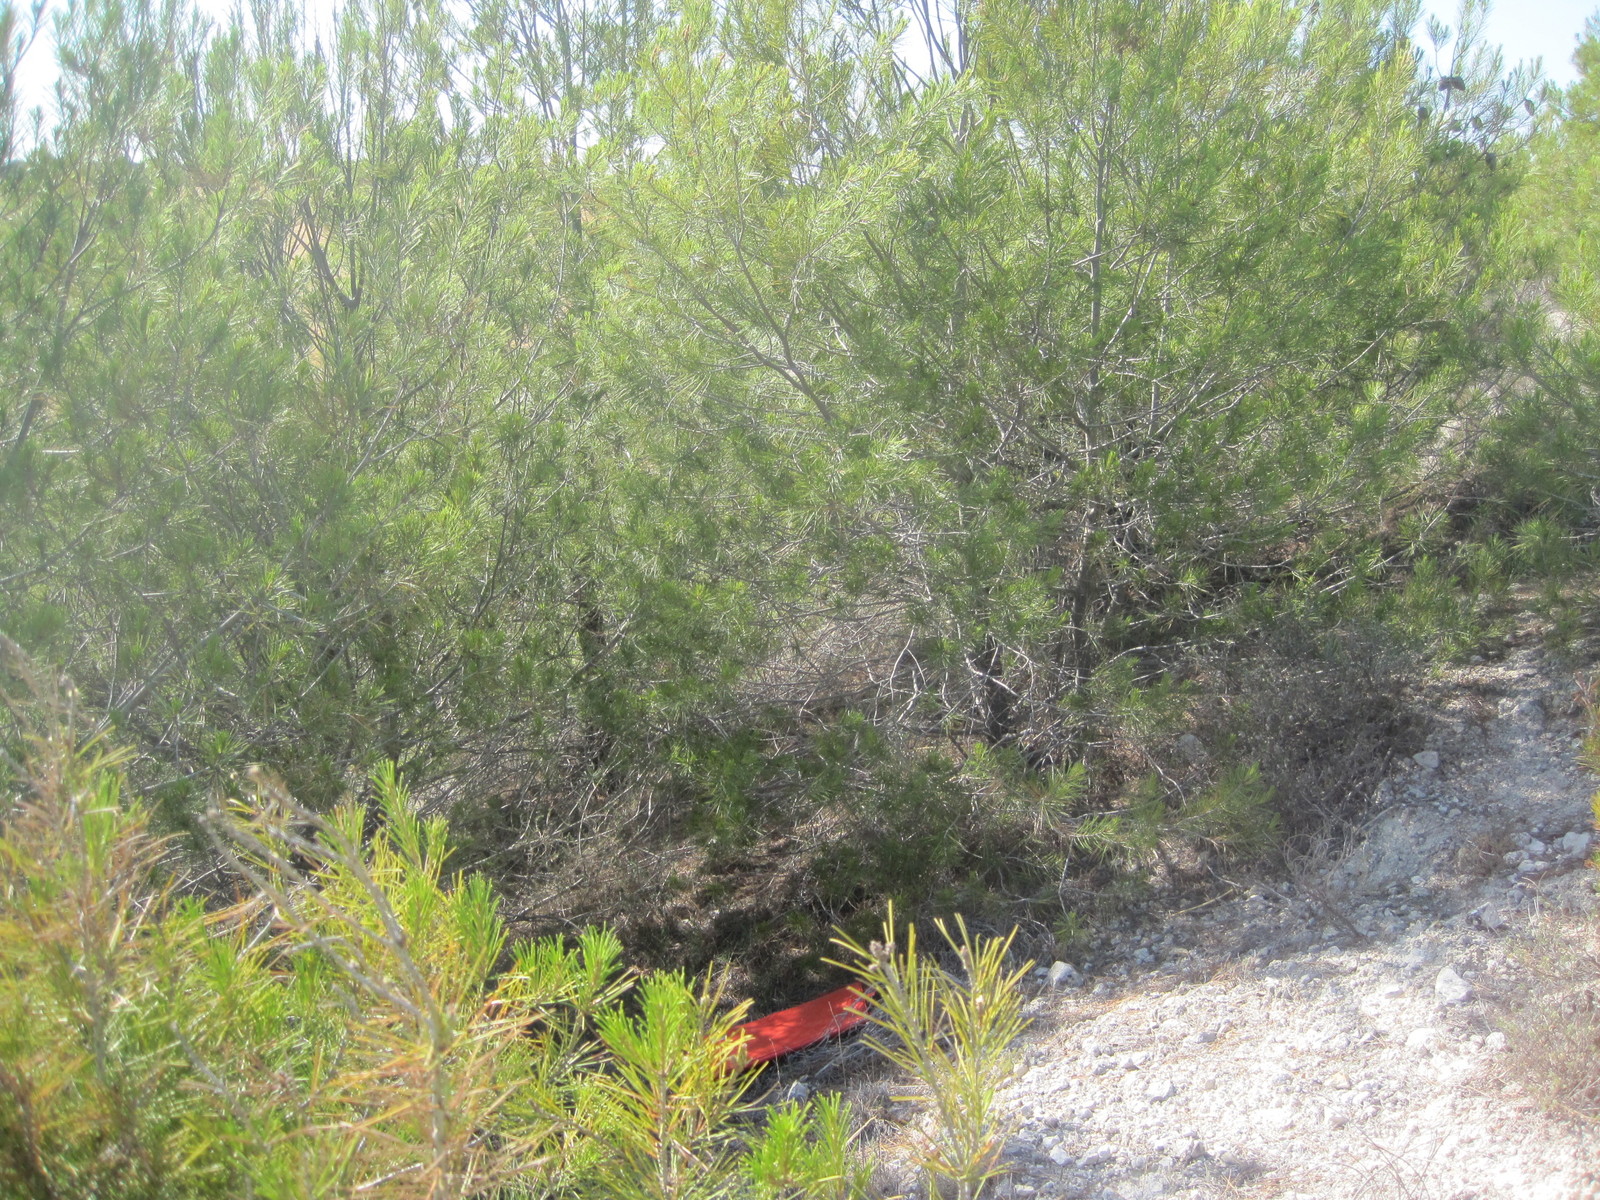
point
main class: Woodland
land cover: Pine dominated coniferous woodland
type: coniferous forest of the mediterranean region
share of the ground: 50 - 75 %
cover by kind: coniferous forest trees 70 %, herbaceous plants 30 %
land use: Semi-natural and natural areas not in use
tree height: > 5 m
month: July
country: ES
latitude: 41.6894
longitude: -5.1556
